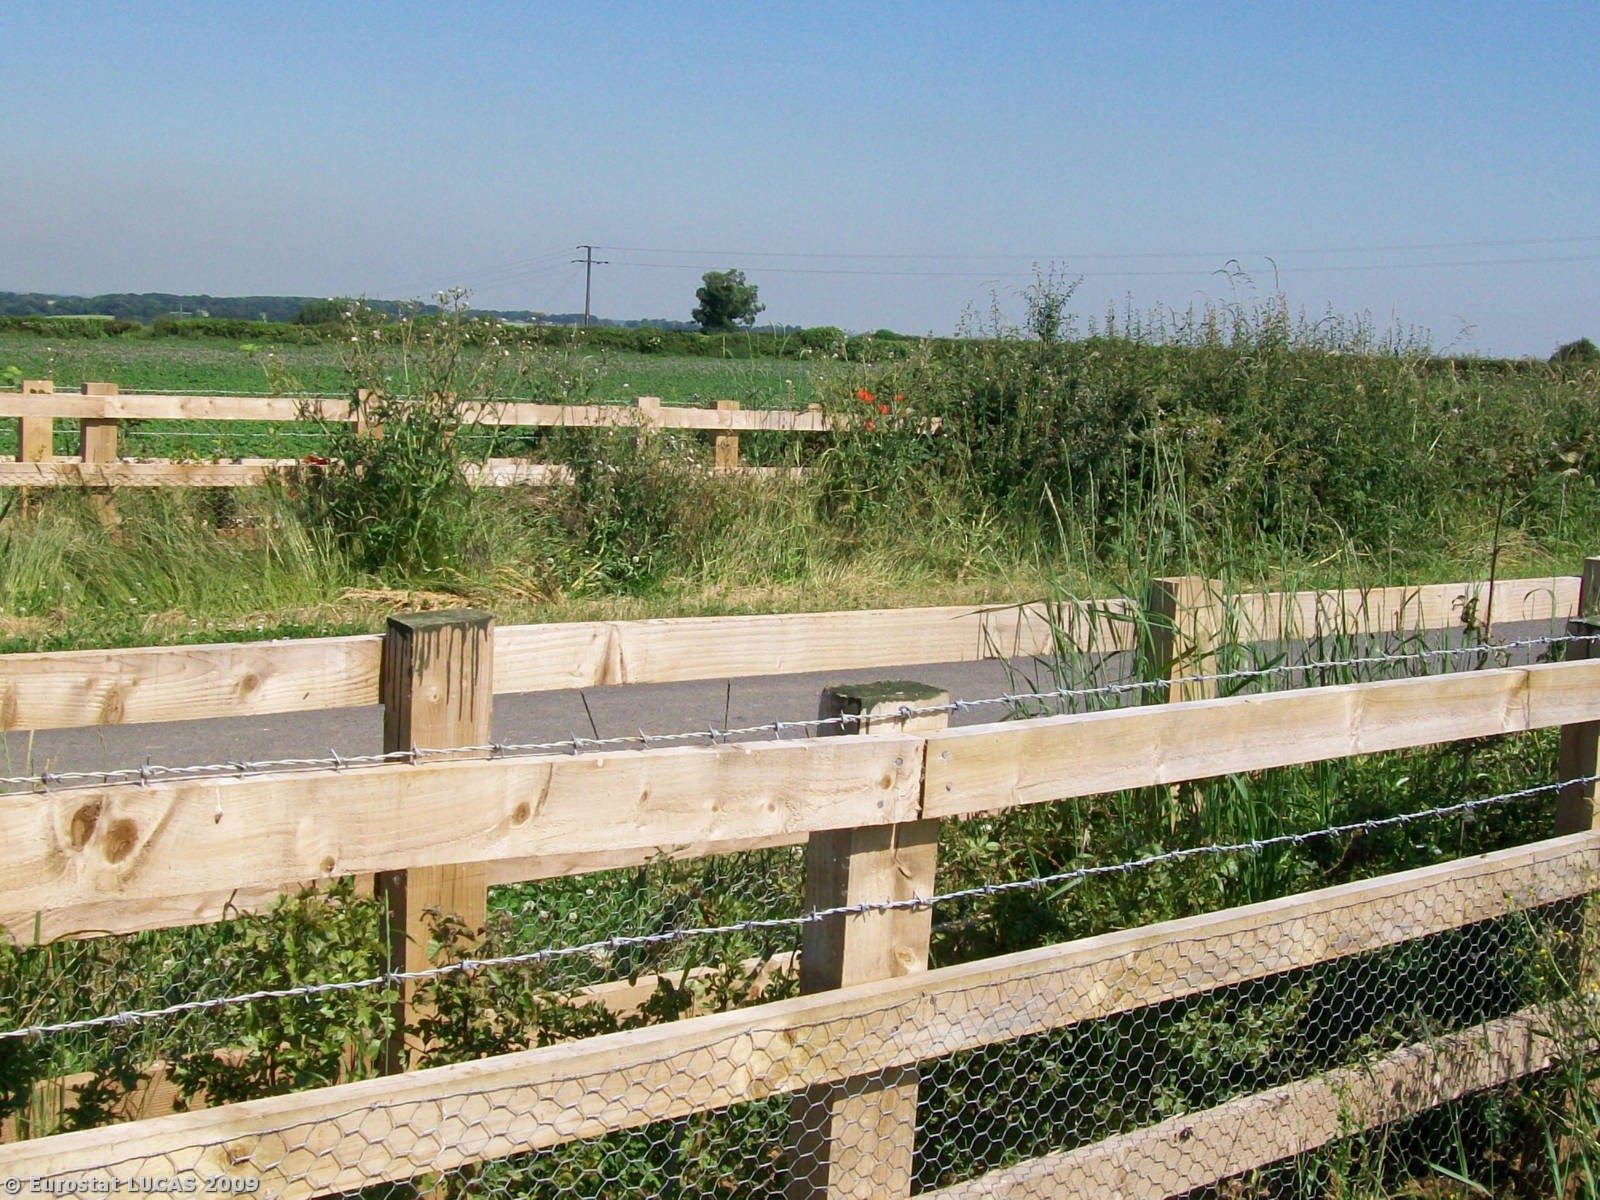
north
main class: Cropland
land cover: Barley
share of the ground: < 10 %
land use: Agriculture (excluding fallow land and kitchen gardens)
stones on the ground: 25 - 50 %
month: July
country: GB
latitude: 53.8955
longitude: -1.4159
